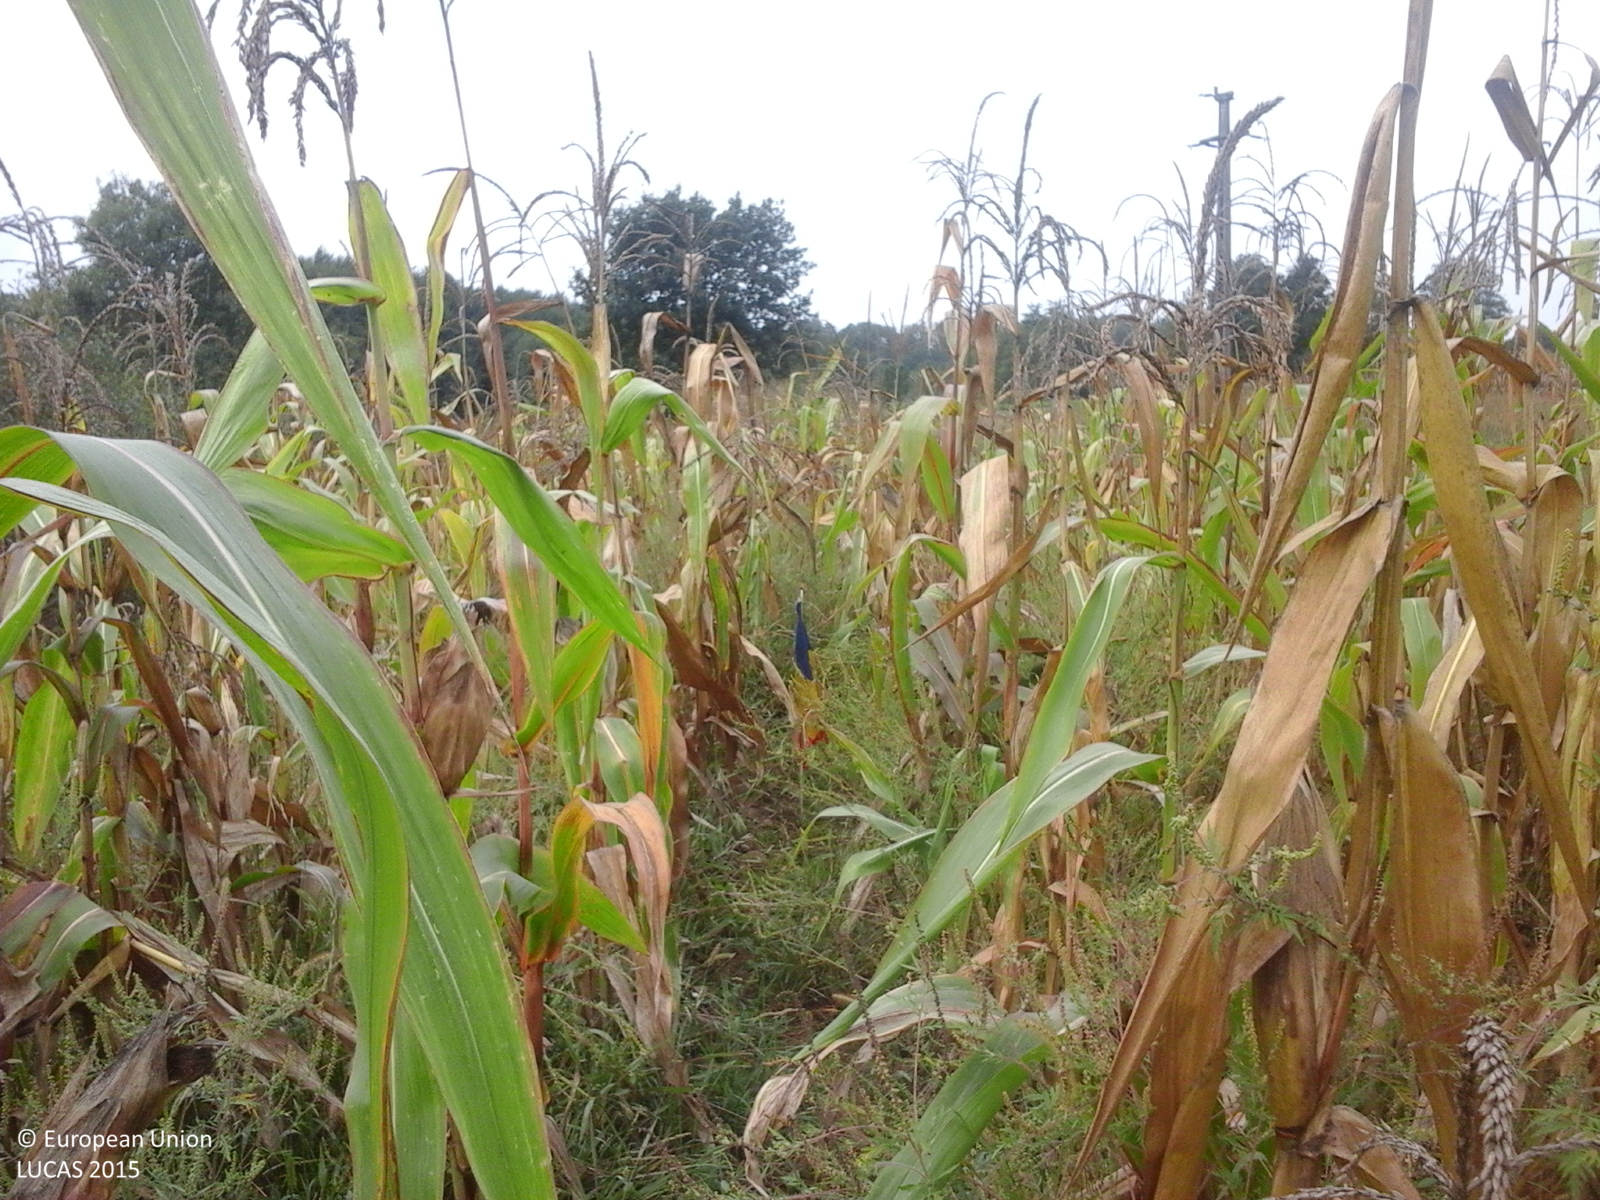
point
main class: Cropland
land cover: Maize
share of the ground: > 75 %
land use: Agriculture (excluding fallow land and kitchen gardens)
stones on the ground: < 10 %
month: September
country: RO
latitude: 45.8280
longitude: 22.2340
